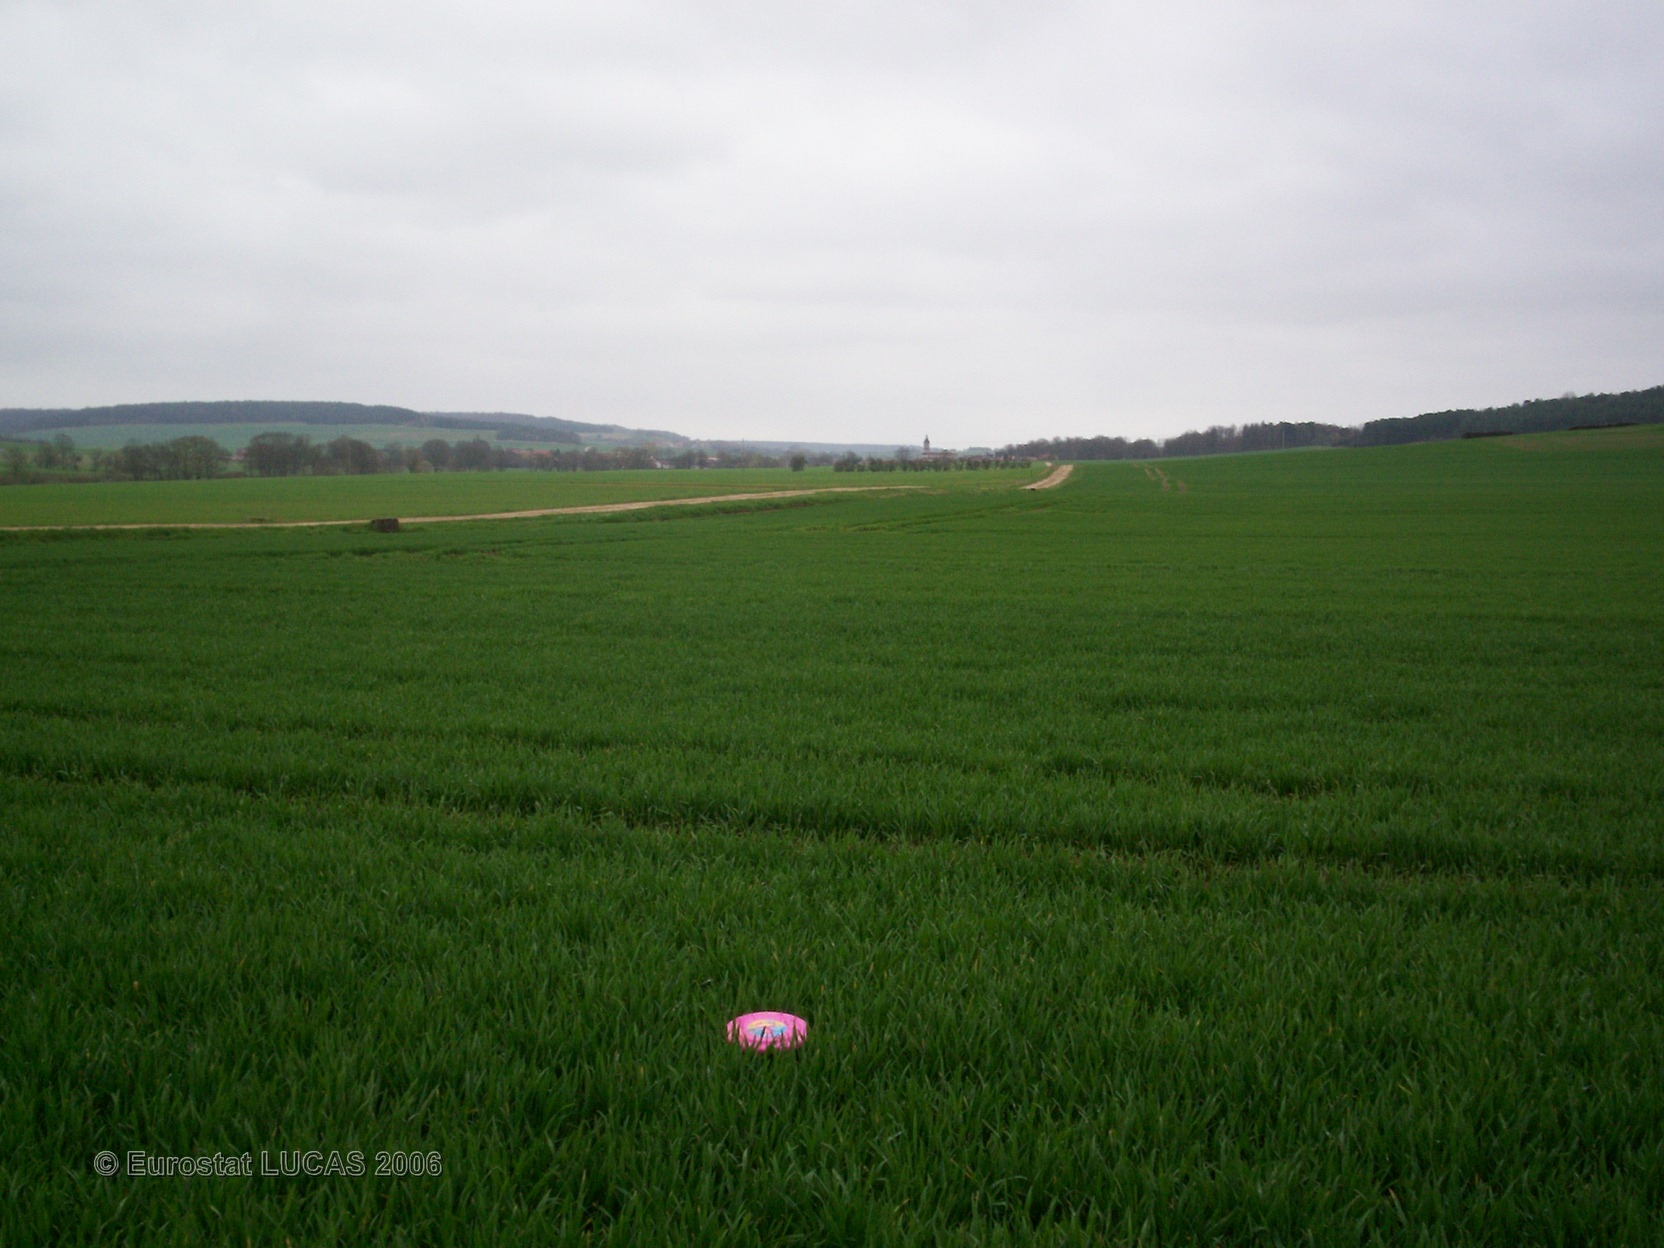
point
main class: Cropland
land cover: Common wheat
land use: Agriculture (excluding fallow land and kitchen gardens)
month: April
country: FR
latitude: 48.1264
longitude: 4.9606
